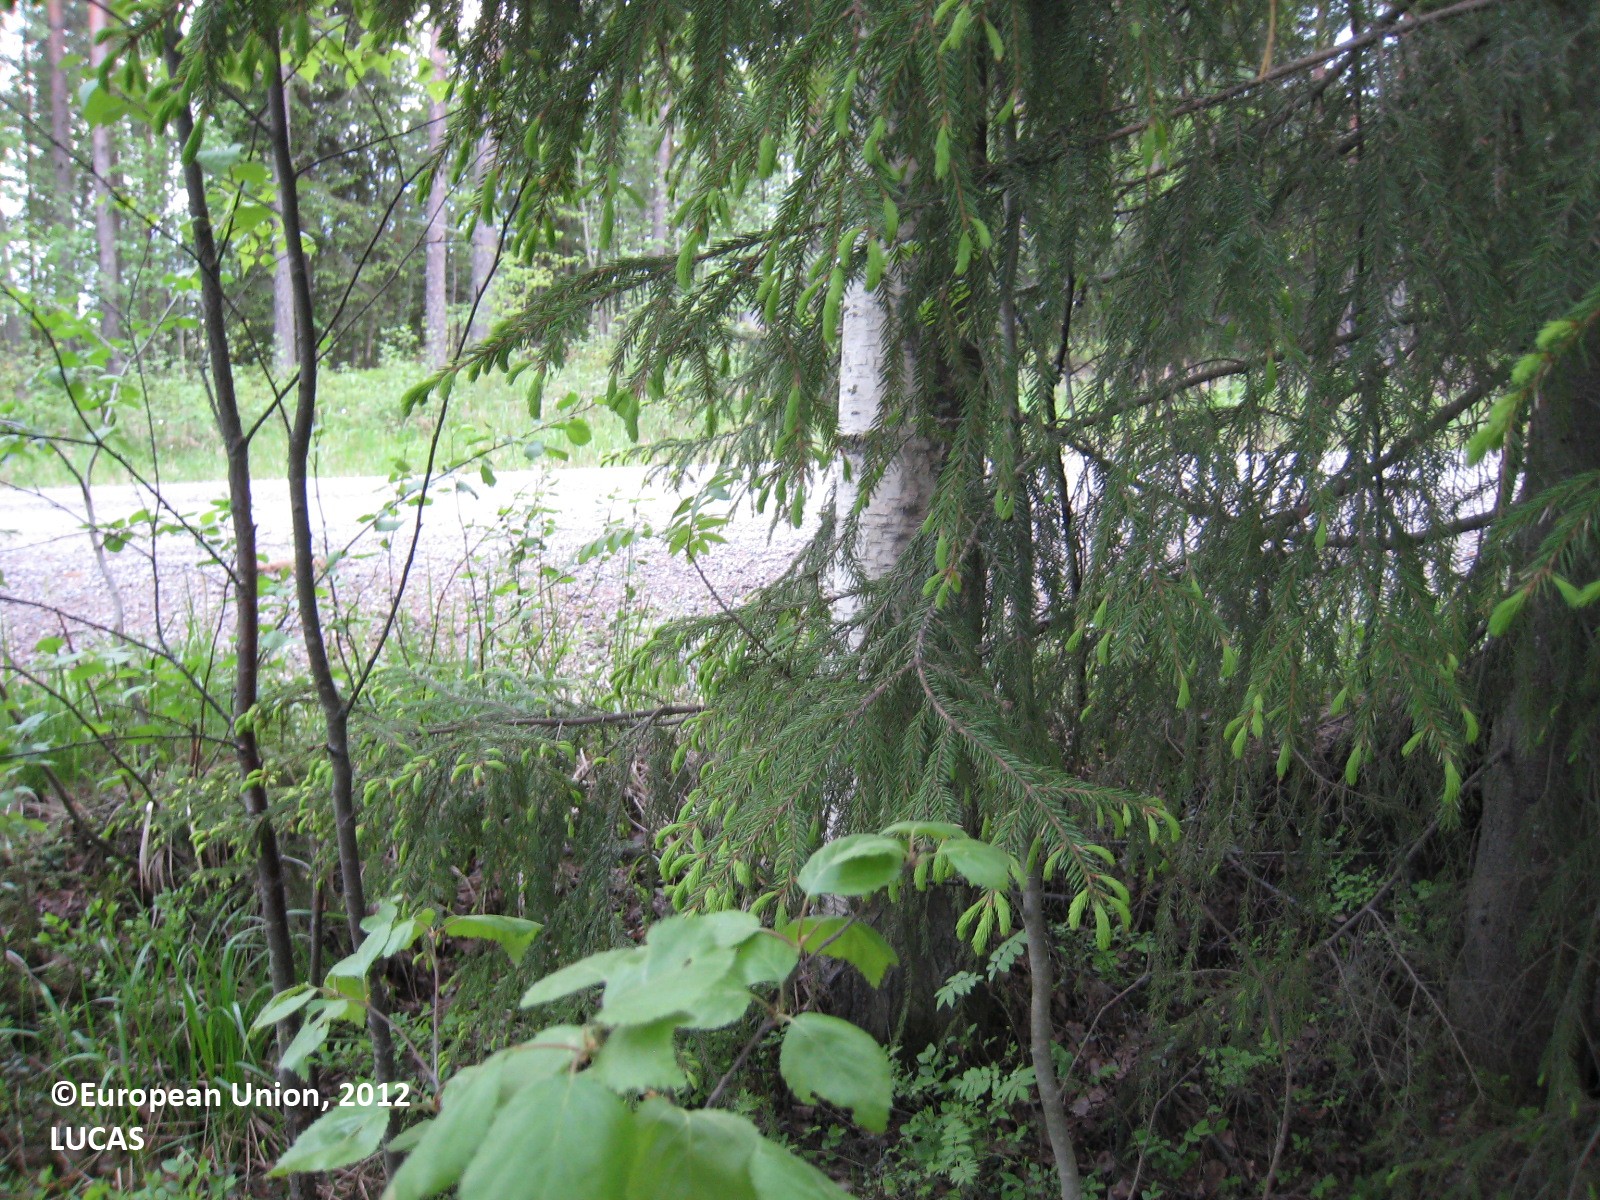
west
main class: Woodland
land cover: Pine dominated mixed woodland
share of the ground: > 75 %
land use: Forestry
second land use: Road transport
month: June
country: FI
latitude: 62.6118
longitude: 26.0438
